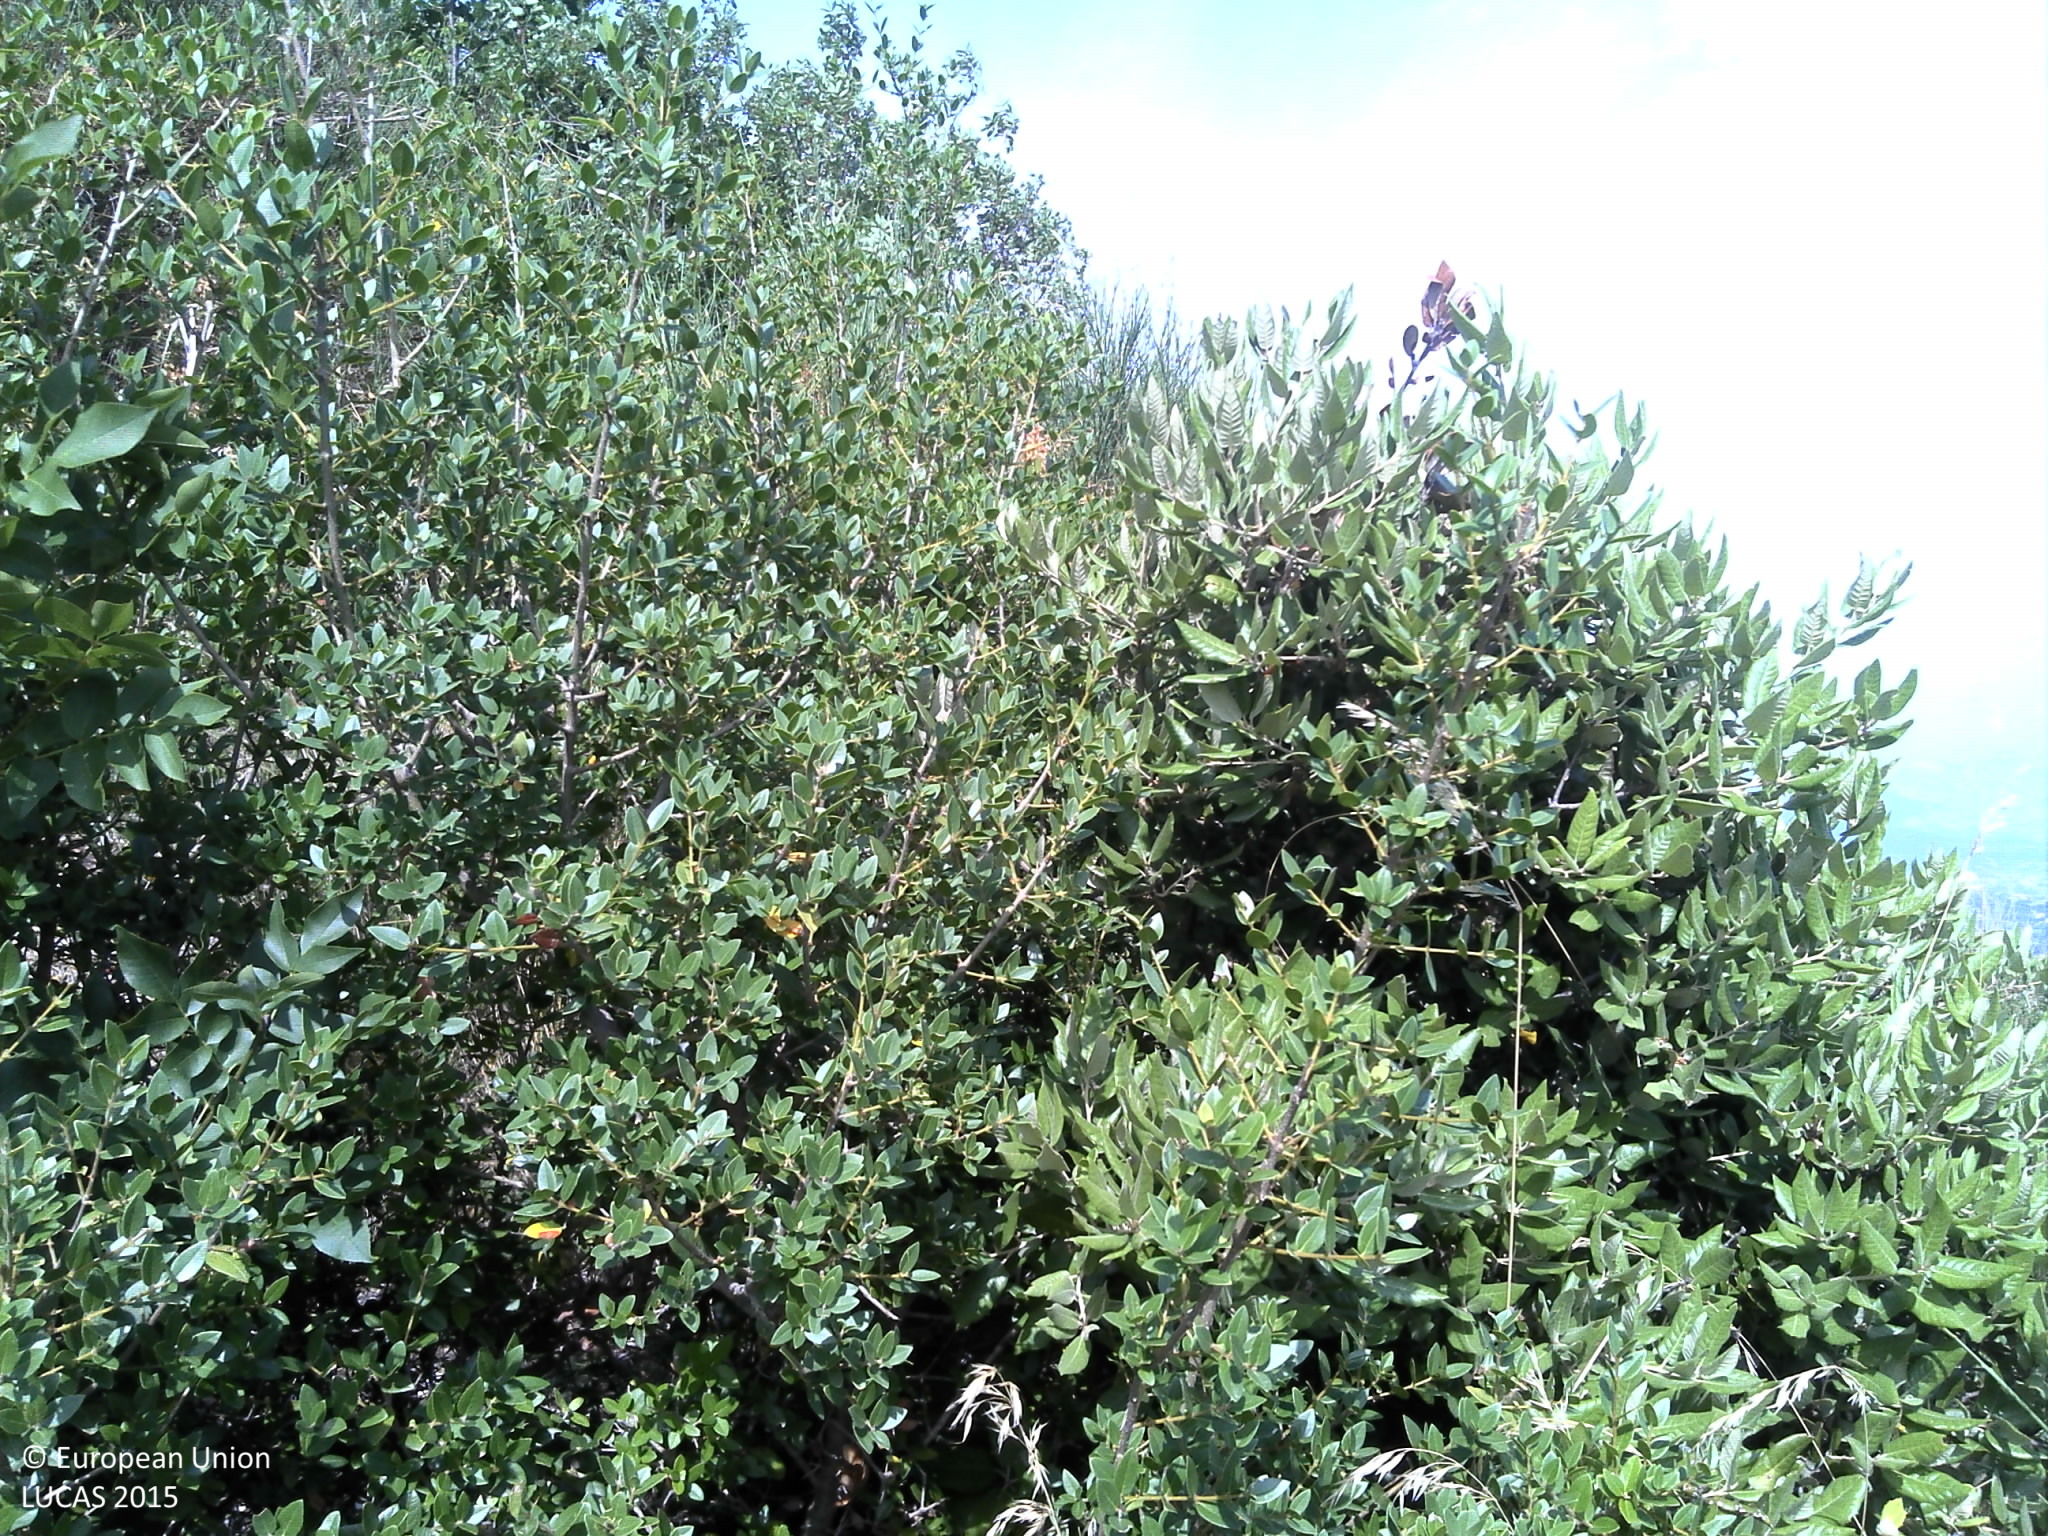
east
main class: Shrubland
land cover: Shrubland with sparse tree cover
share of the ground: > 75 %
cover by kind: shrubs 75 %, herbaceous plants 10 %, broadleaved forest trees 5 %, consolidated bare surface 5 %, unconsolidated bare surface 5 %
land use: Semi-natural and natural areas not in use
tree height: < 5 m
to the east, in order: Shrubland with sparse tree cover; Shrubland without tree cover; Grassland with sparse tree/shrub cover
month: June
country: HR
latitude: 43.5790
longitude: 16.3189
